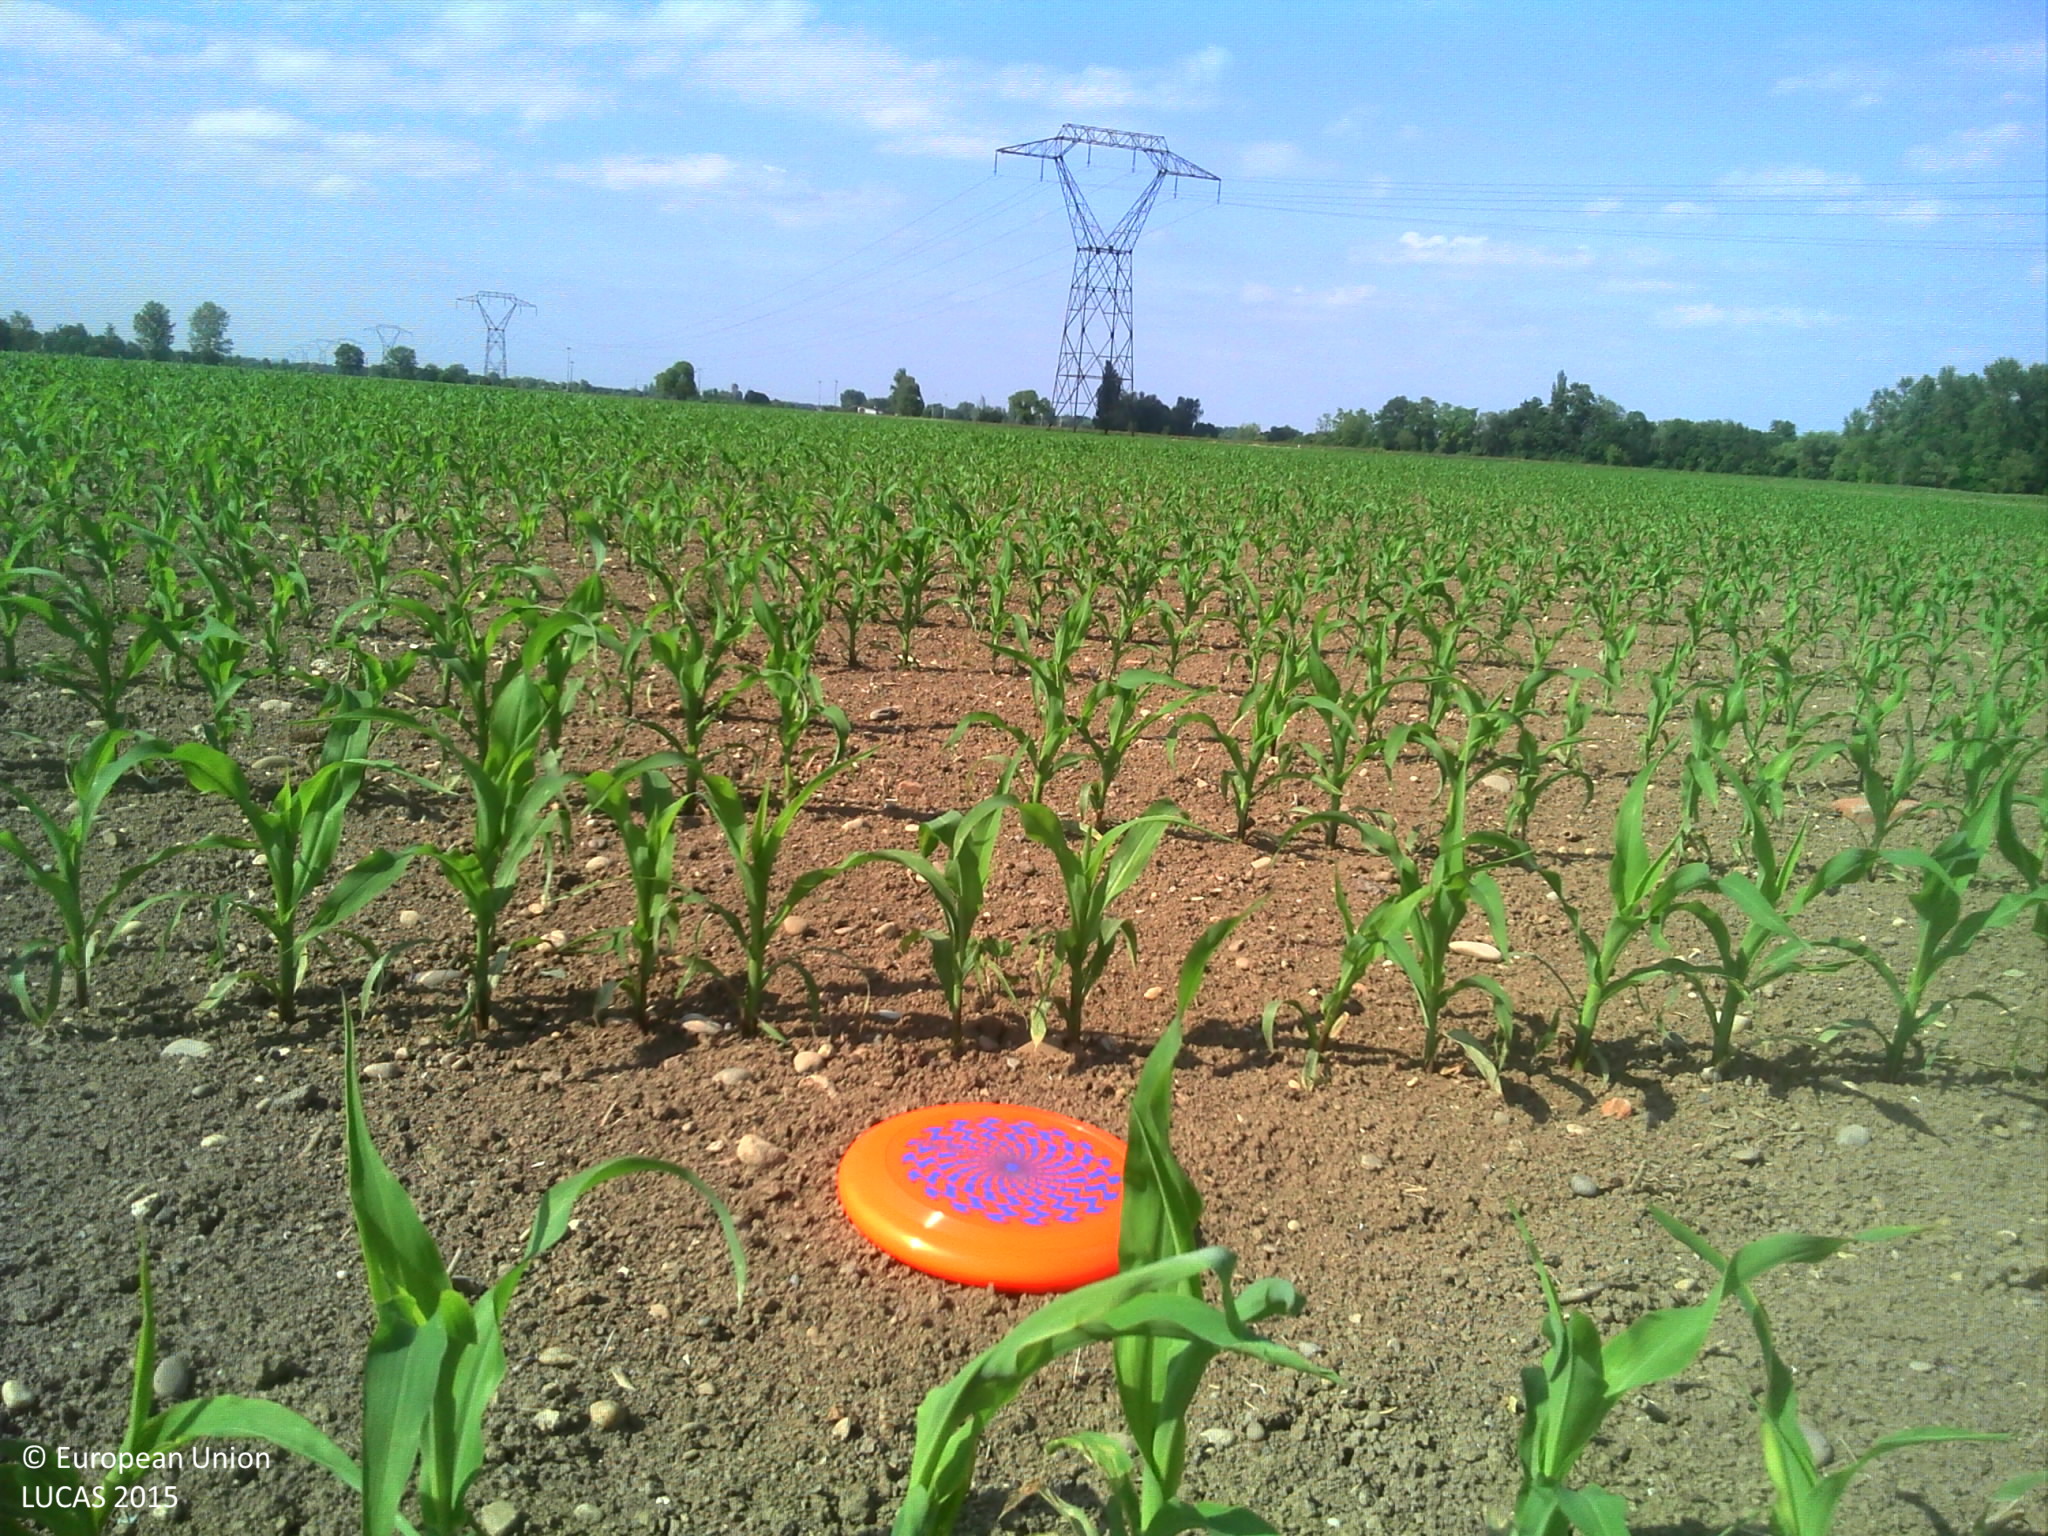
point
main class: Cropland
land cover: Maize
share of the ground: 10 - 25 %
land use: Agriculture (excluding fallow land and kitchen gardens)
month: May
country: FR
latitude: 48.3040
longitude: 7.5338
